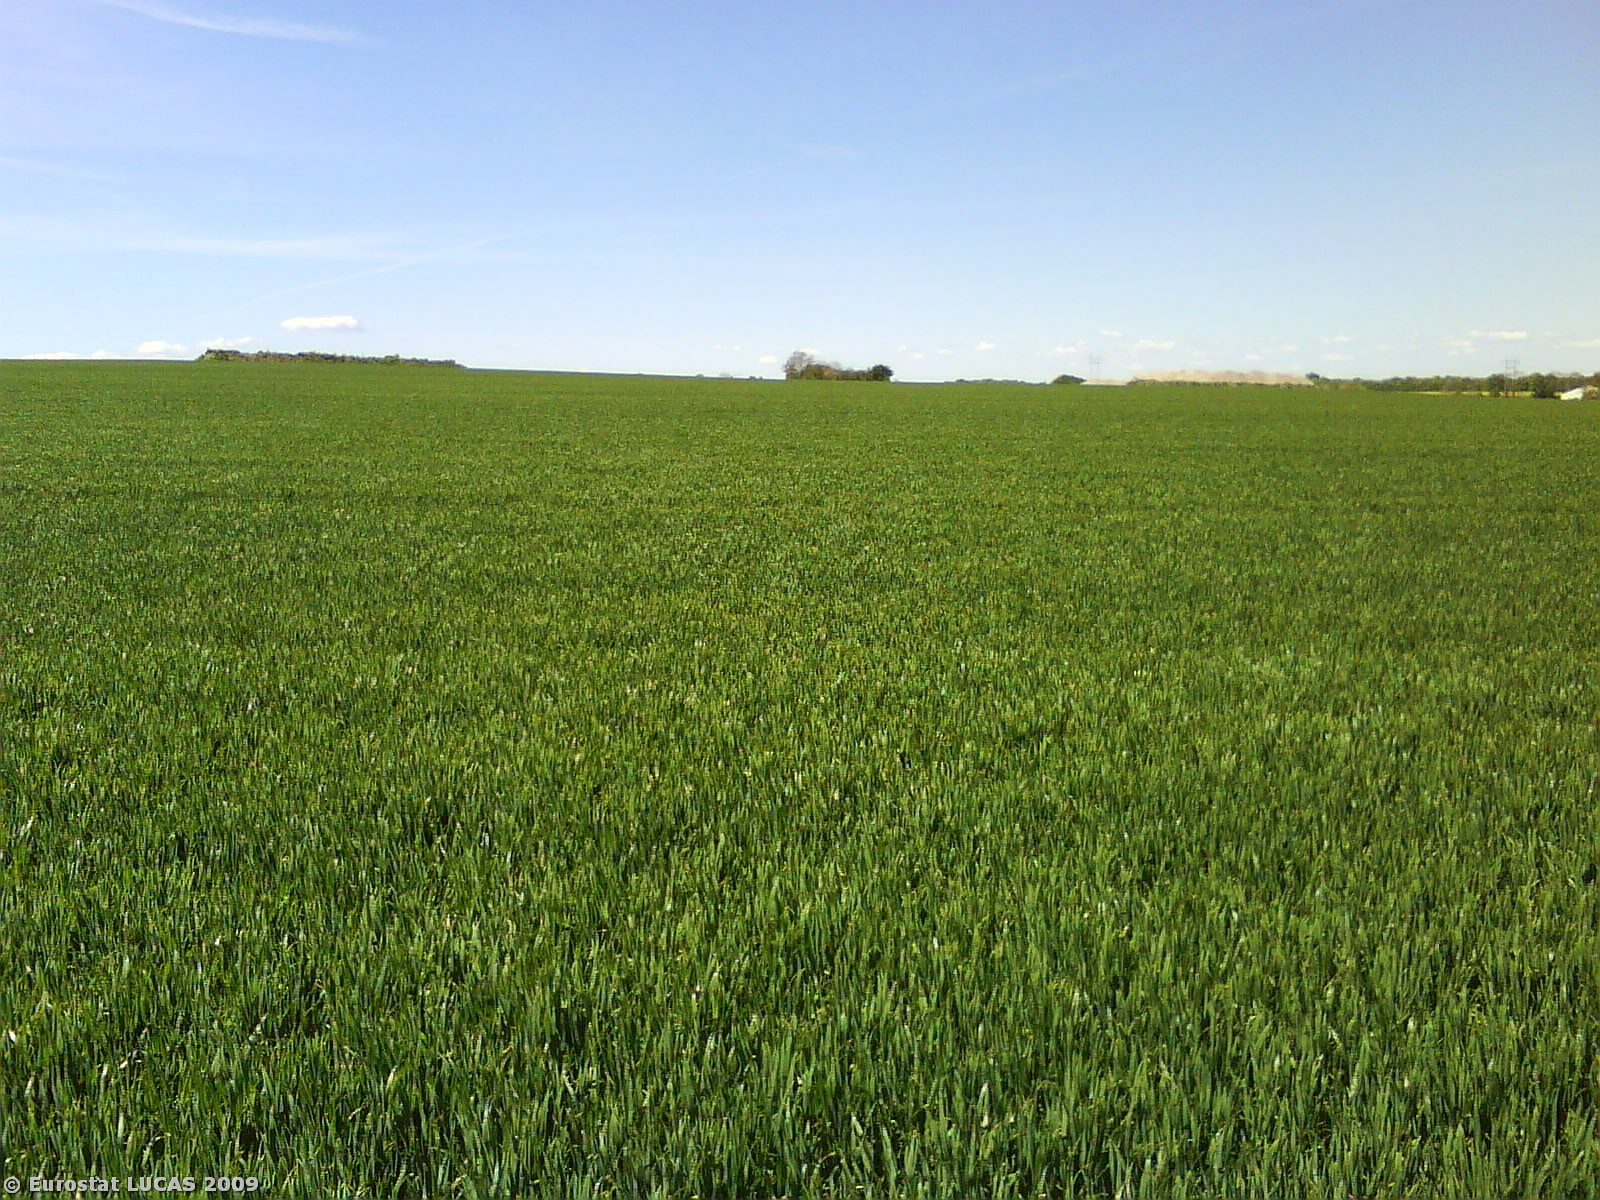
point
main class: Cropland
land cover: Common wheat
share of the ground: > 75 %
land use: Agriculture (excluding fallow land and kitchen gardens)
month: May
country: DK
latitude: 56.3824
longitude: 10.8896
